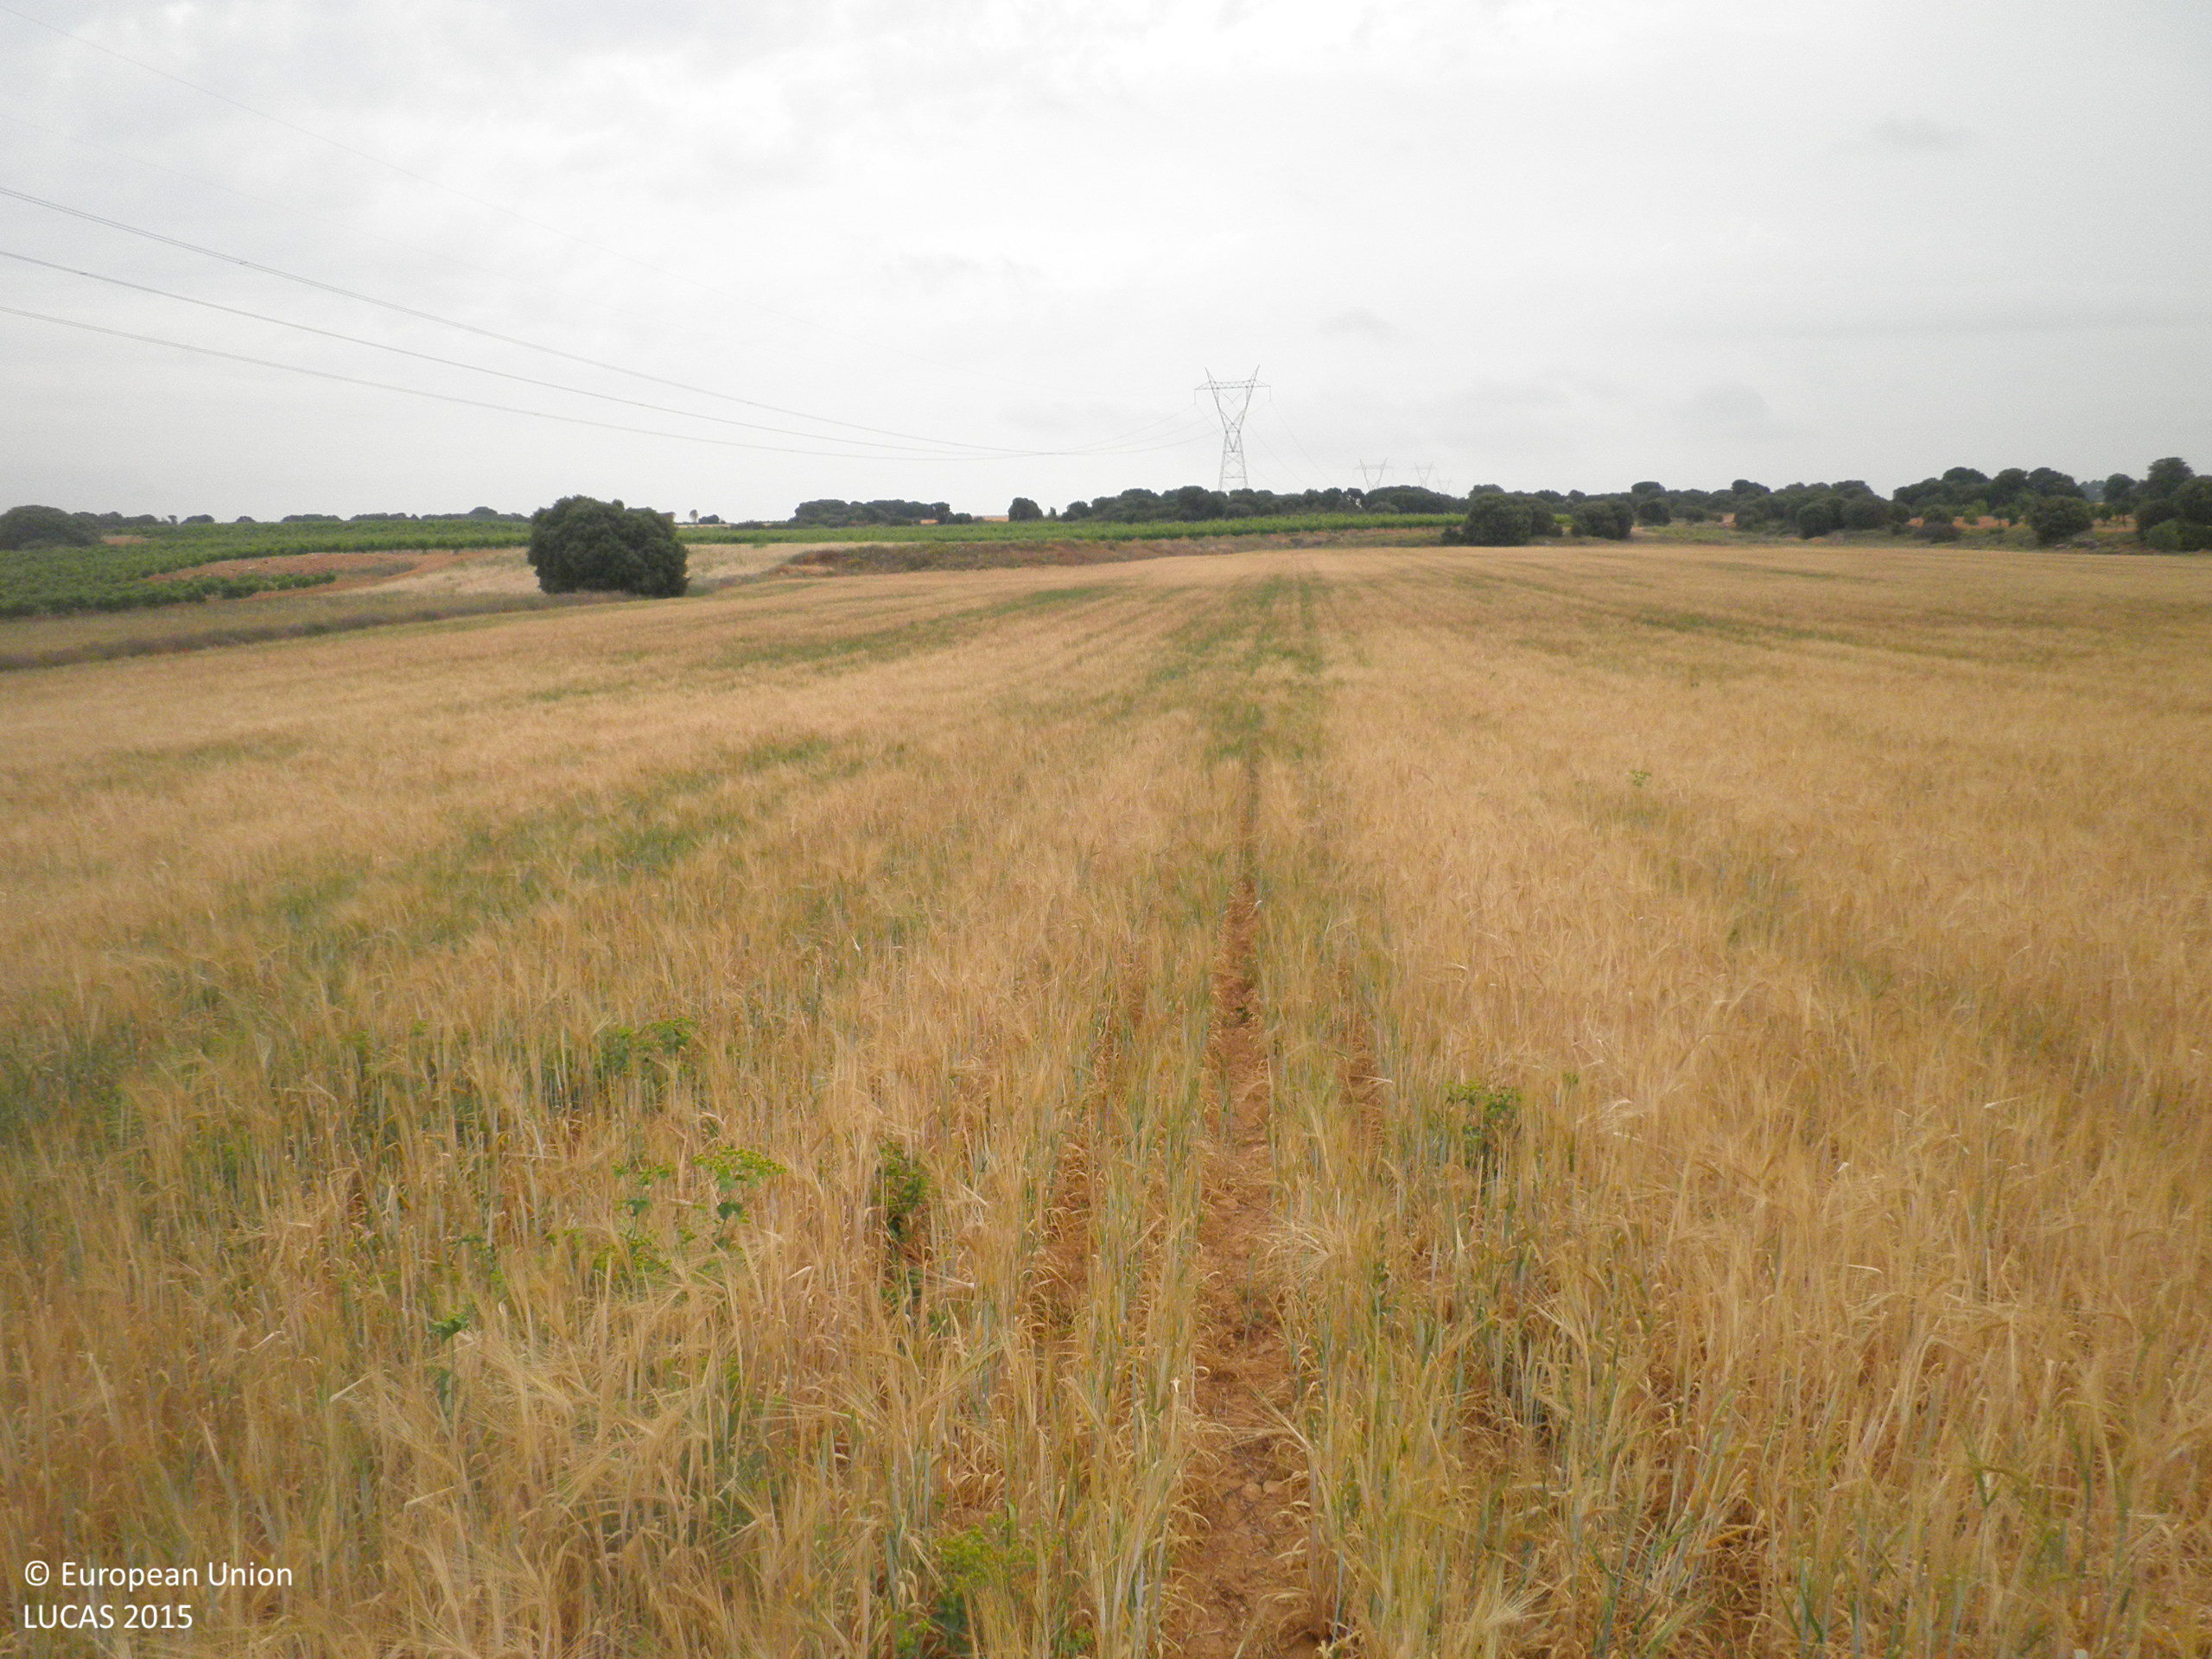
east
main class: Cropland
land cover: Barley
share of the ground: > 75 %
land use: Agriculture (excluding fallow land and kitchen gardens)
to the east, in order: Barley; Broadleaved woodland; Grass margins; Tracks; Grass margins; Vineyards
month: June
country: ES
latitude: 39.5257
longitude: -1.7206
